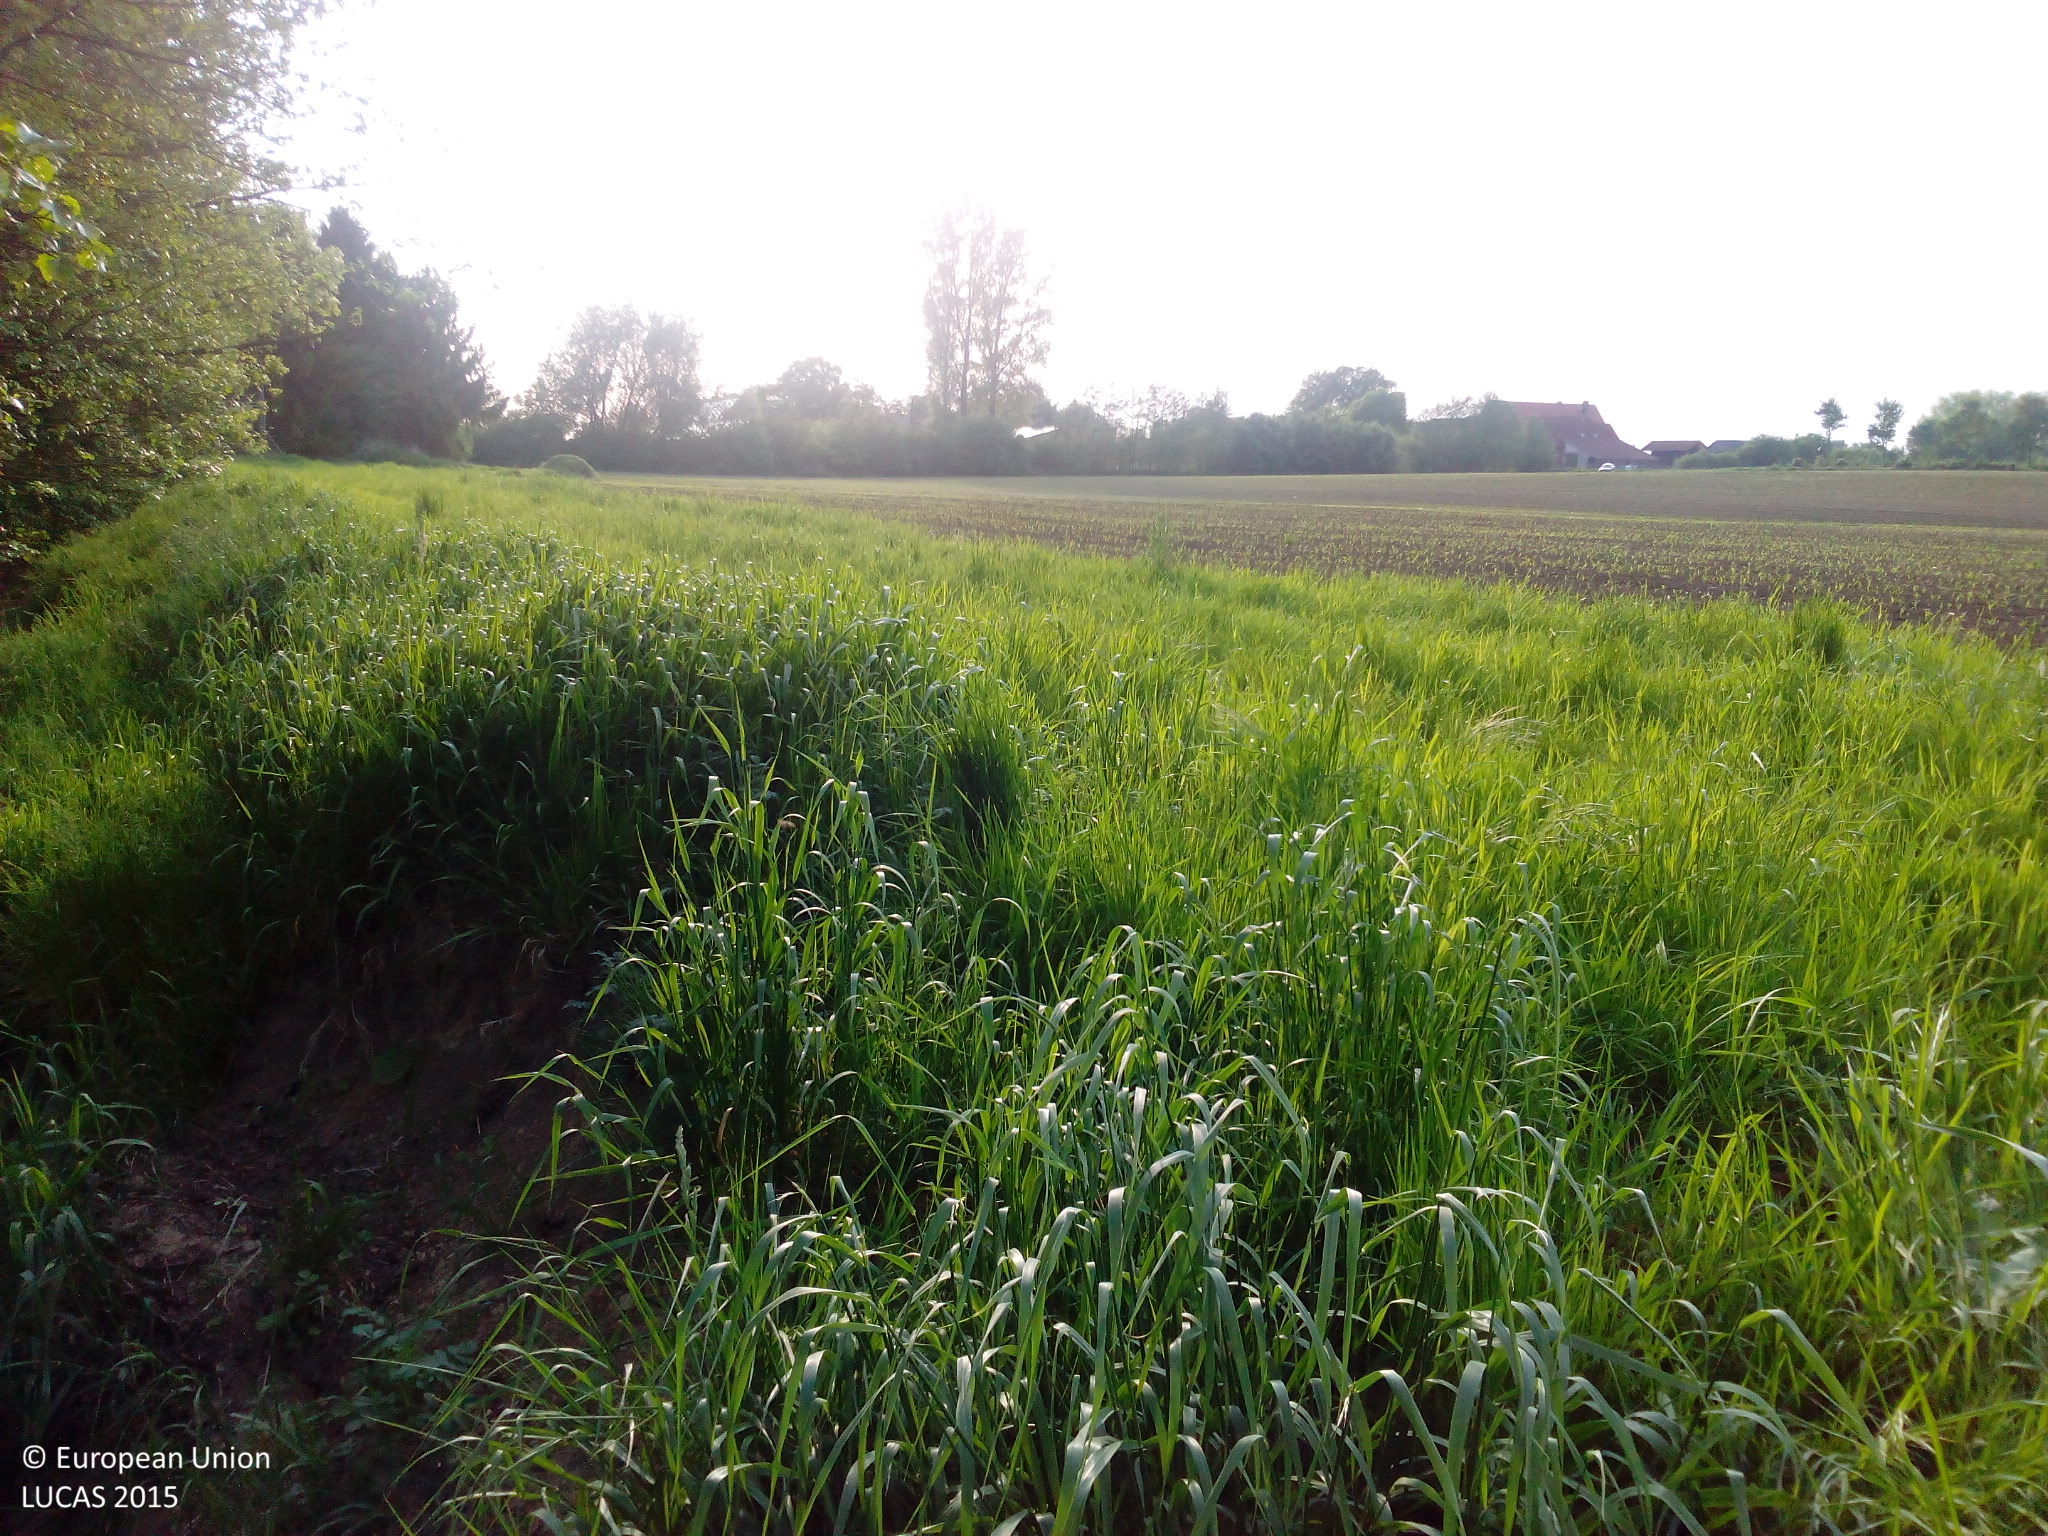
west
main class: Grassland
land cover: Grassland without tree/shrub cover
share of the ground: > 75 %
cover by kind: herbaceous plants 100 %
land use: Agriculture (excluding fallow land and kitchen gardens)
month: May
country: DE
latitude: 51.8389
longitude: 7.9830
